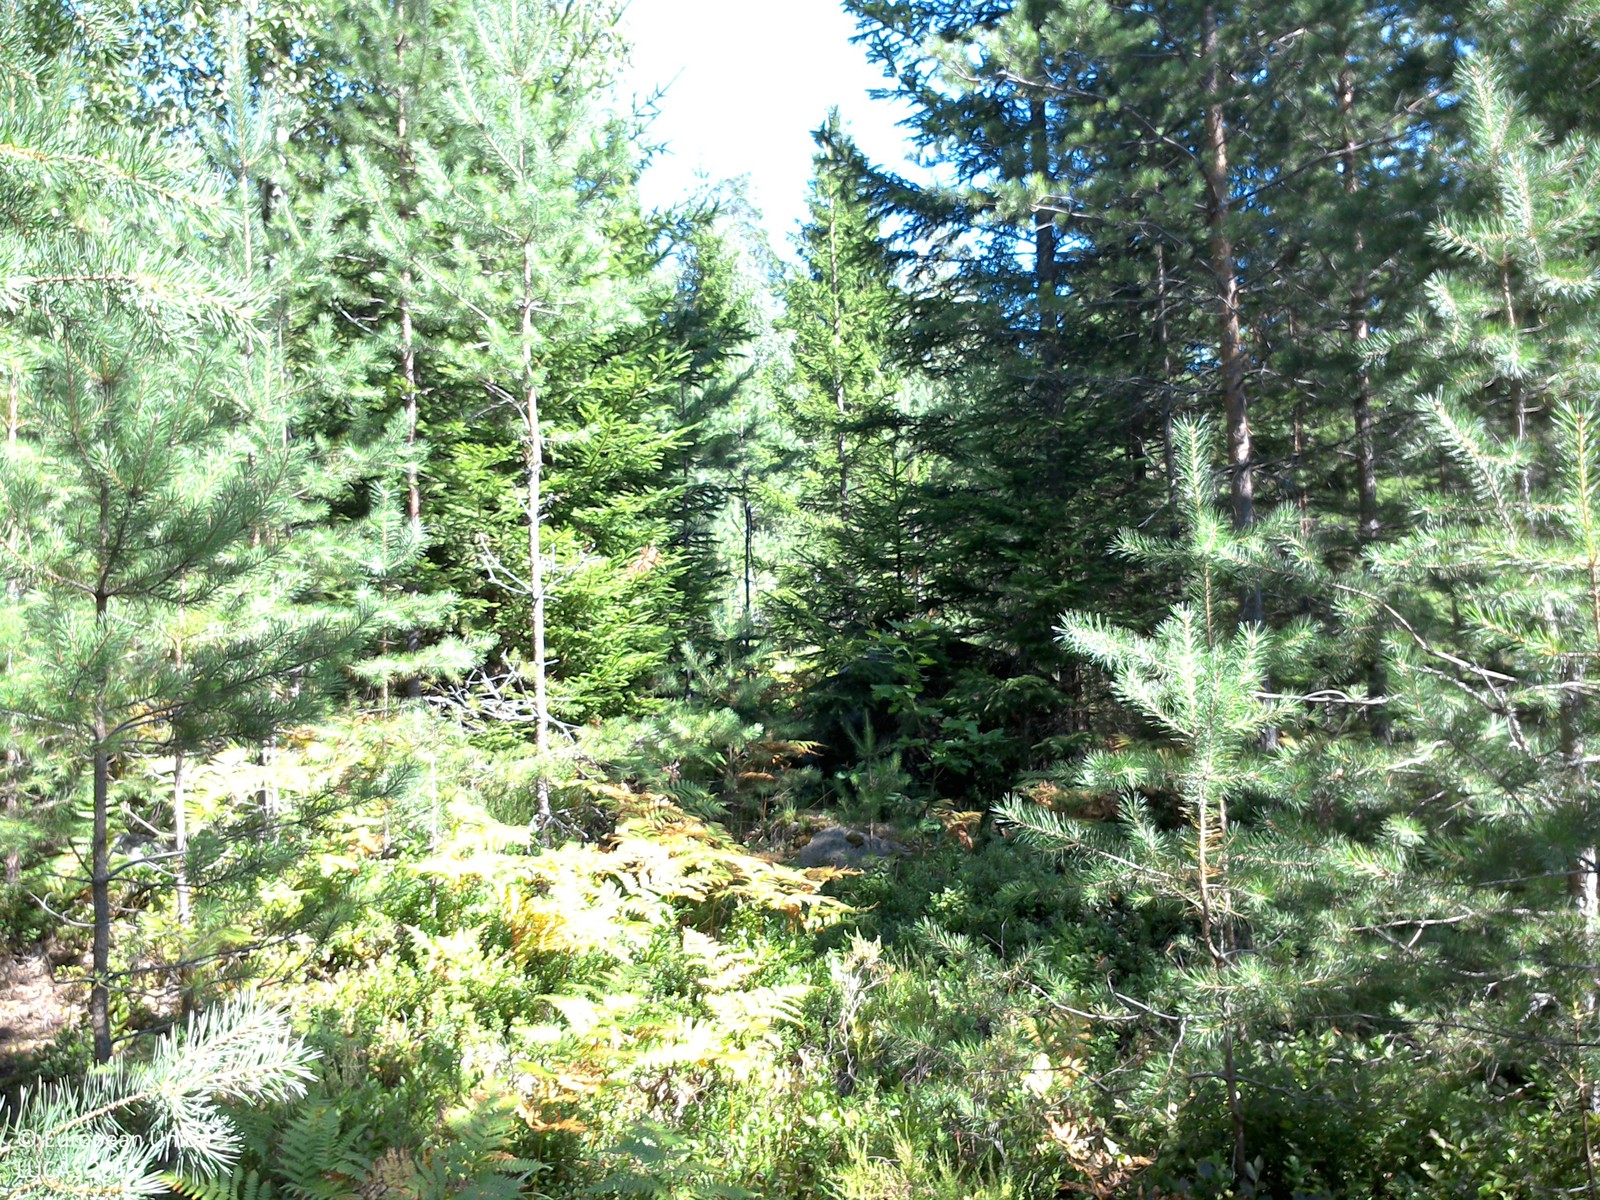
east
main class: Woodland
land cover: Pine dominated coniferous woodland
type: boreal forest
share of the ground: 50 - 75 %
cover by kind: coniferous forest trees 60 %, herbaceous plants 40 %
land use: Forestry
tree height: > 5 m
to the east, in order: Pine dominated coniferous woodland; Pine dominated mixed woodland
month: August
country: SE
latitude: 57.8652
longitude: 15.6766
